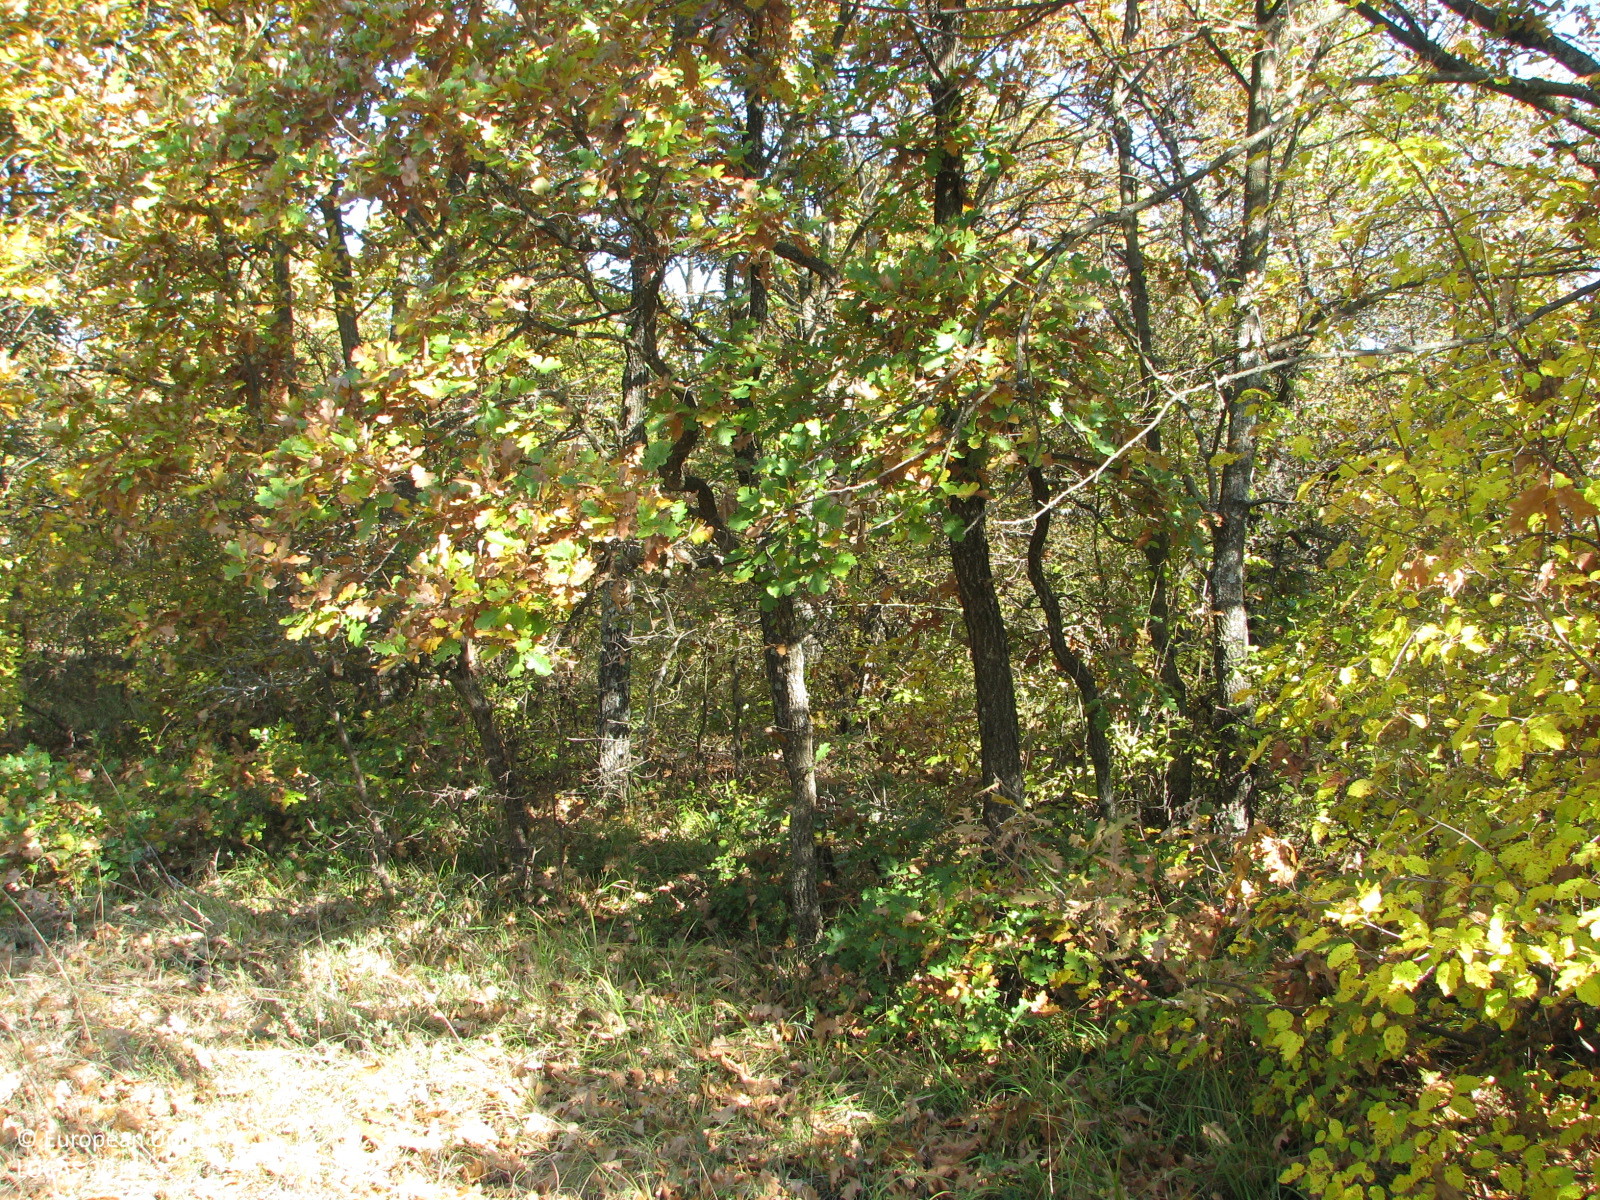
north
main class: Woodland
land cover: Broadleaved woodland
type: thermophilous deciduous forest
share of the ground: 50 - 75 %
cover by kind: broadleaved forest trees 60 %, herbaceous plants 30 %, shrubs 10 %
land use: Semi-natural and natural areas not in use
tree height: > 5 m
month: November
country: BG
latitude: 42.0955
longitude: 26.7419
